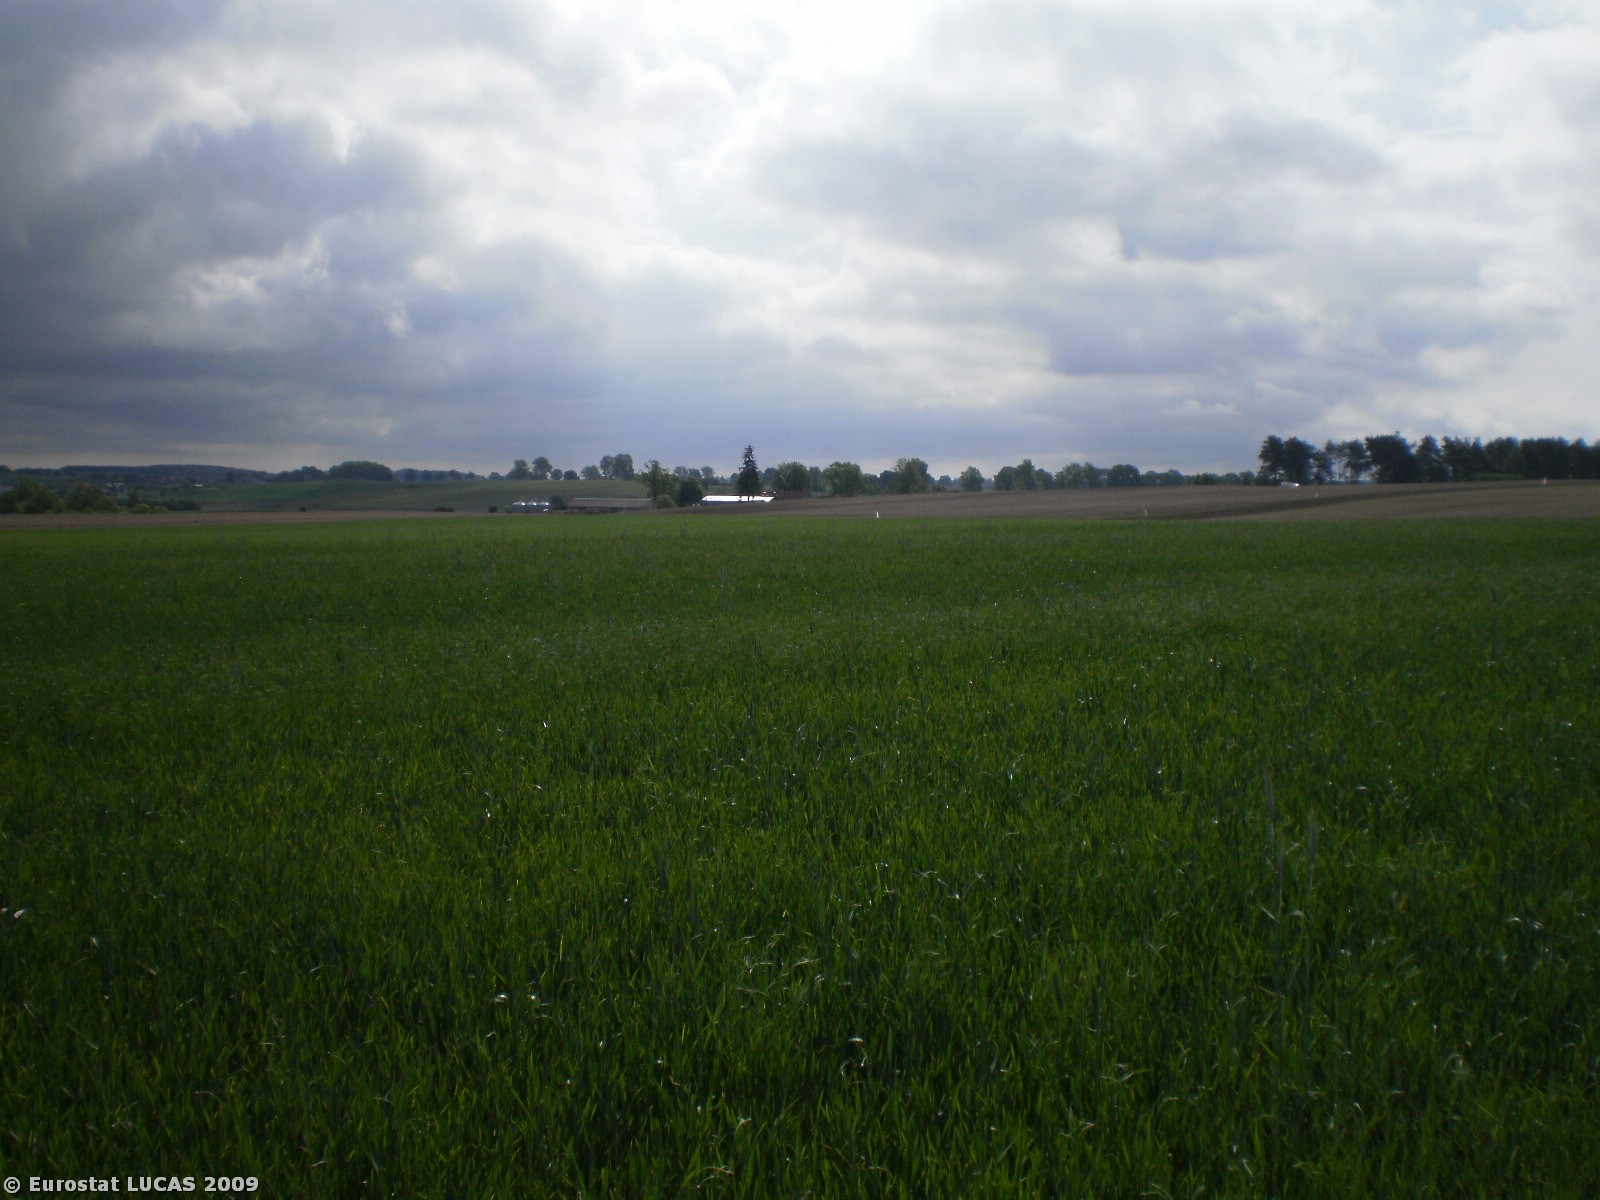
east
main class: Cropland
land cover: Rye
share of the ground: > 75 %
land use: Agriculture (excluding fallow land and kitchen gardens)
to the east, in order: Rye; Barley; Maize
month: May
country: PL
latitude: 53.5542
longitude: 17.6960
